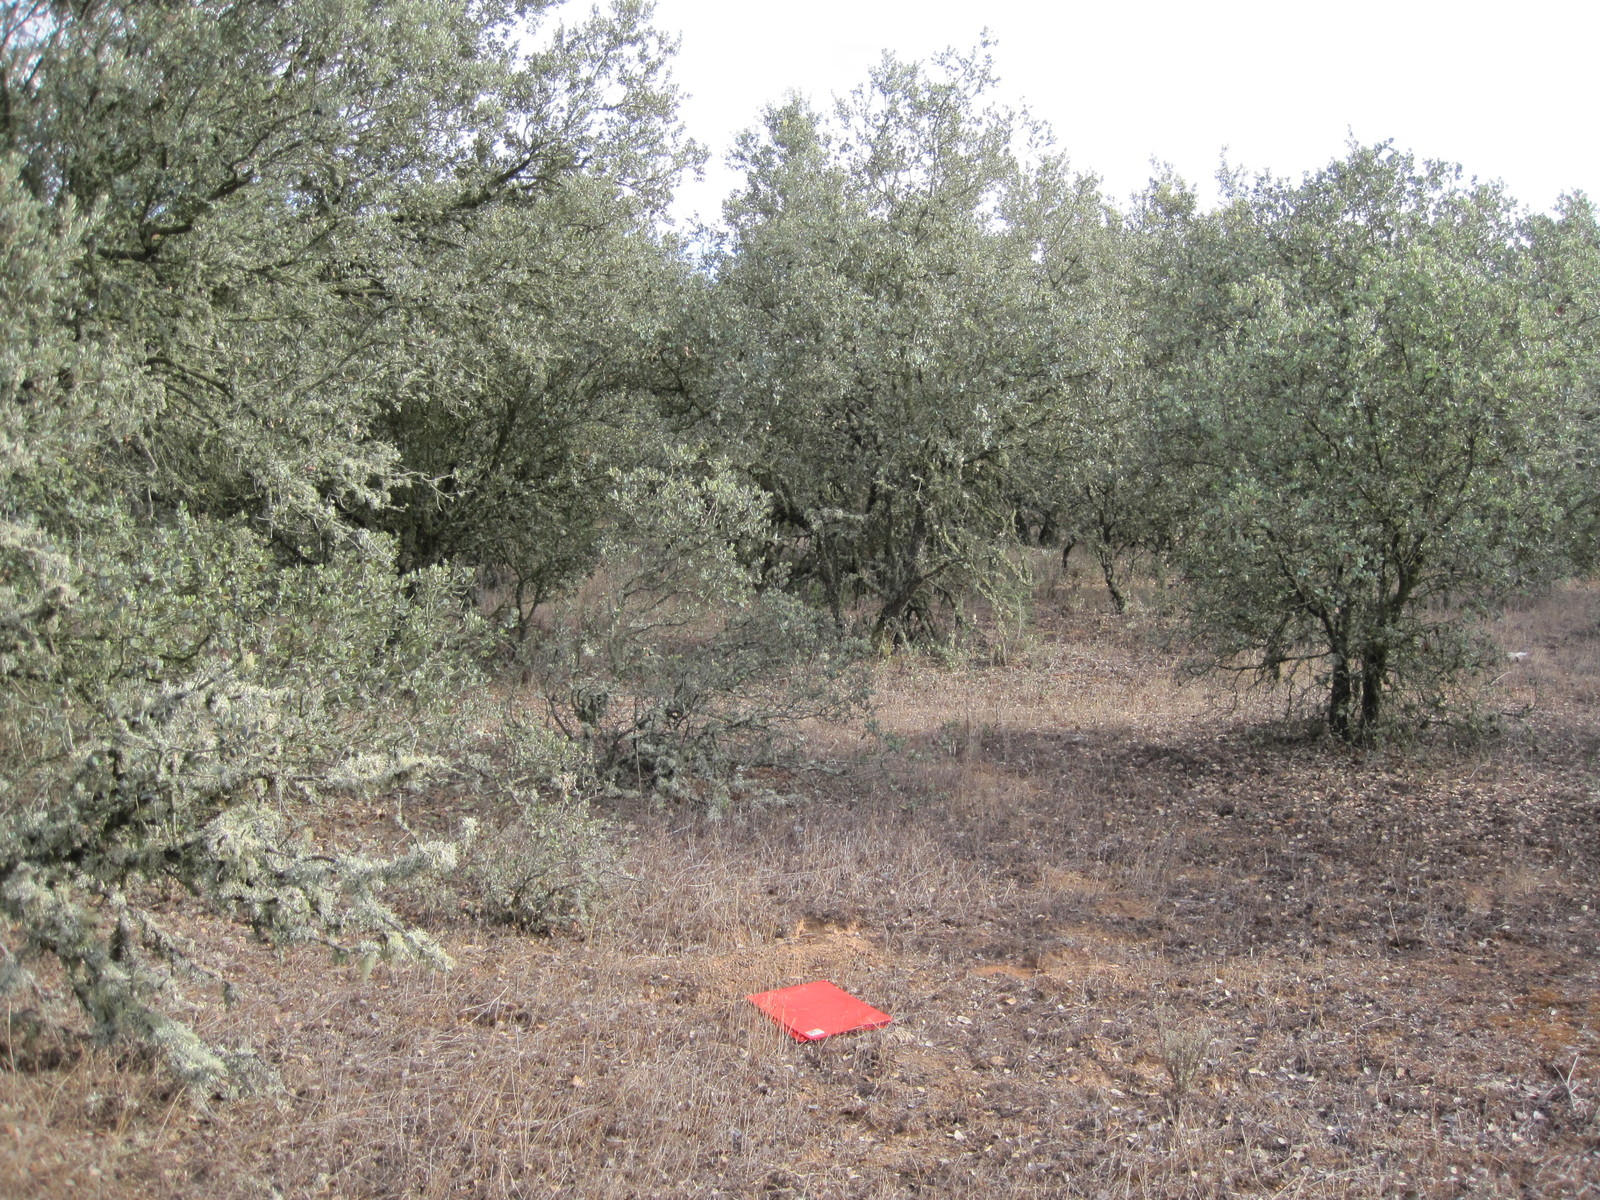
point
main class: Woodland
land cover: Broadleaved woodland
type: broadleaved evergreen forest
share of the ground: 50 - 75 %
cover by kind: broadleaved forest trees 70 %, herbaceous plants 30 %
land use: Forestry
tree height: > 5 m
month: July
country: ES
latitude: 41.9270
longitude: -5.6340
